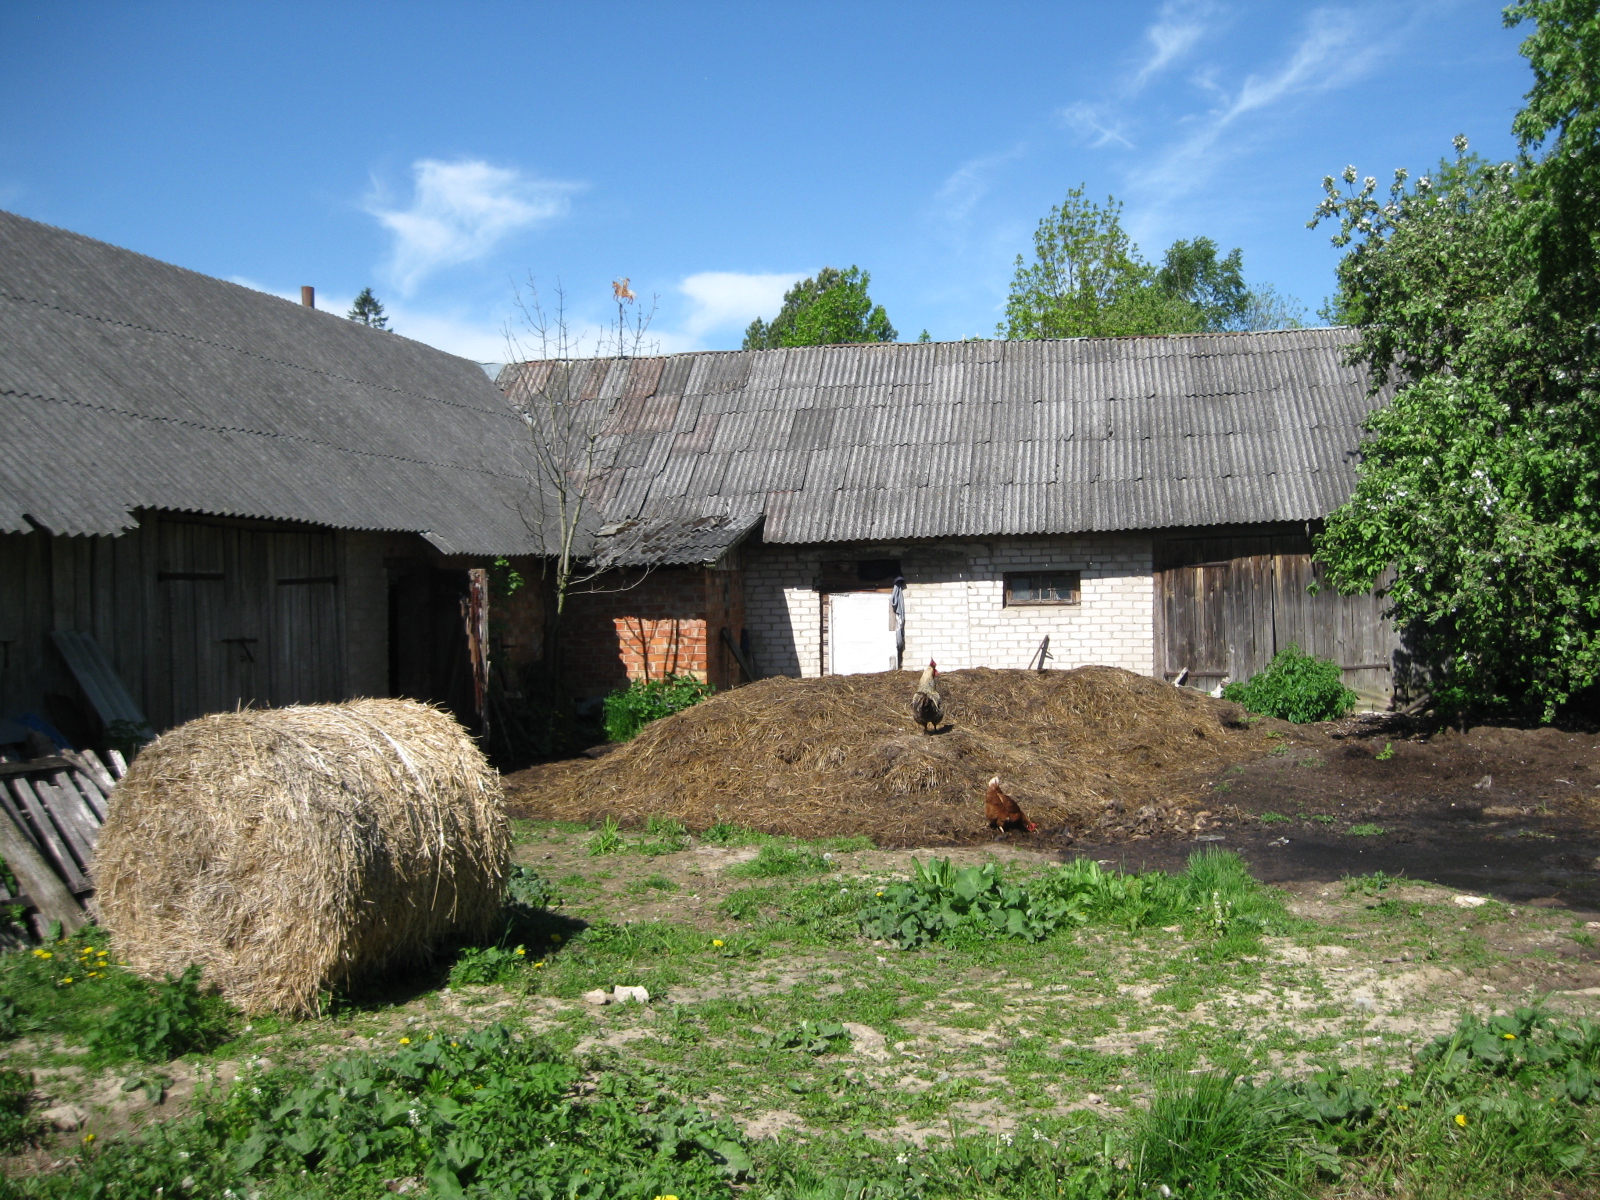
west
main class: Grassland
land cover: Spontaneously vegetated surfaces
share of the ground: 50 - 75 %
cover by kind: herbaceous plants 60 %, unconsolidated bare surface 40 %
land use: Residential
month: May
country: LT
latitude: 56.1207
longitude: 24.0660
